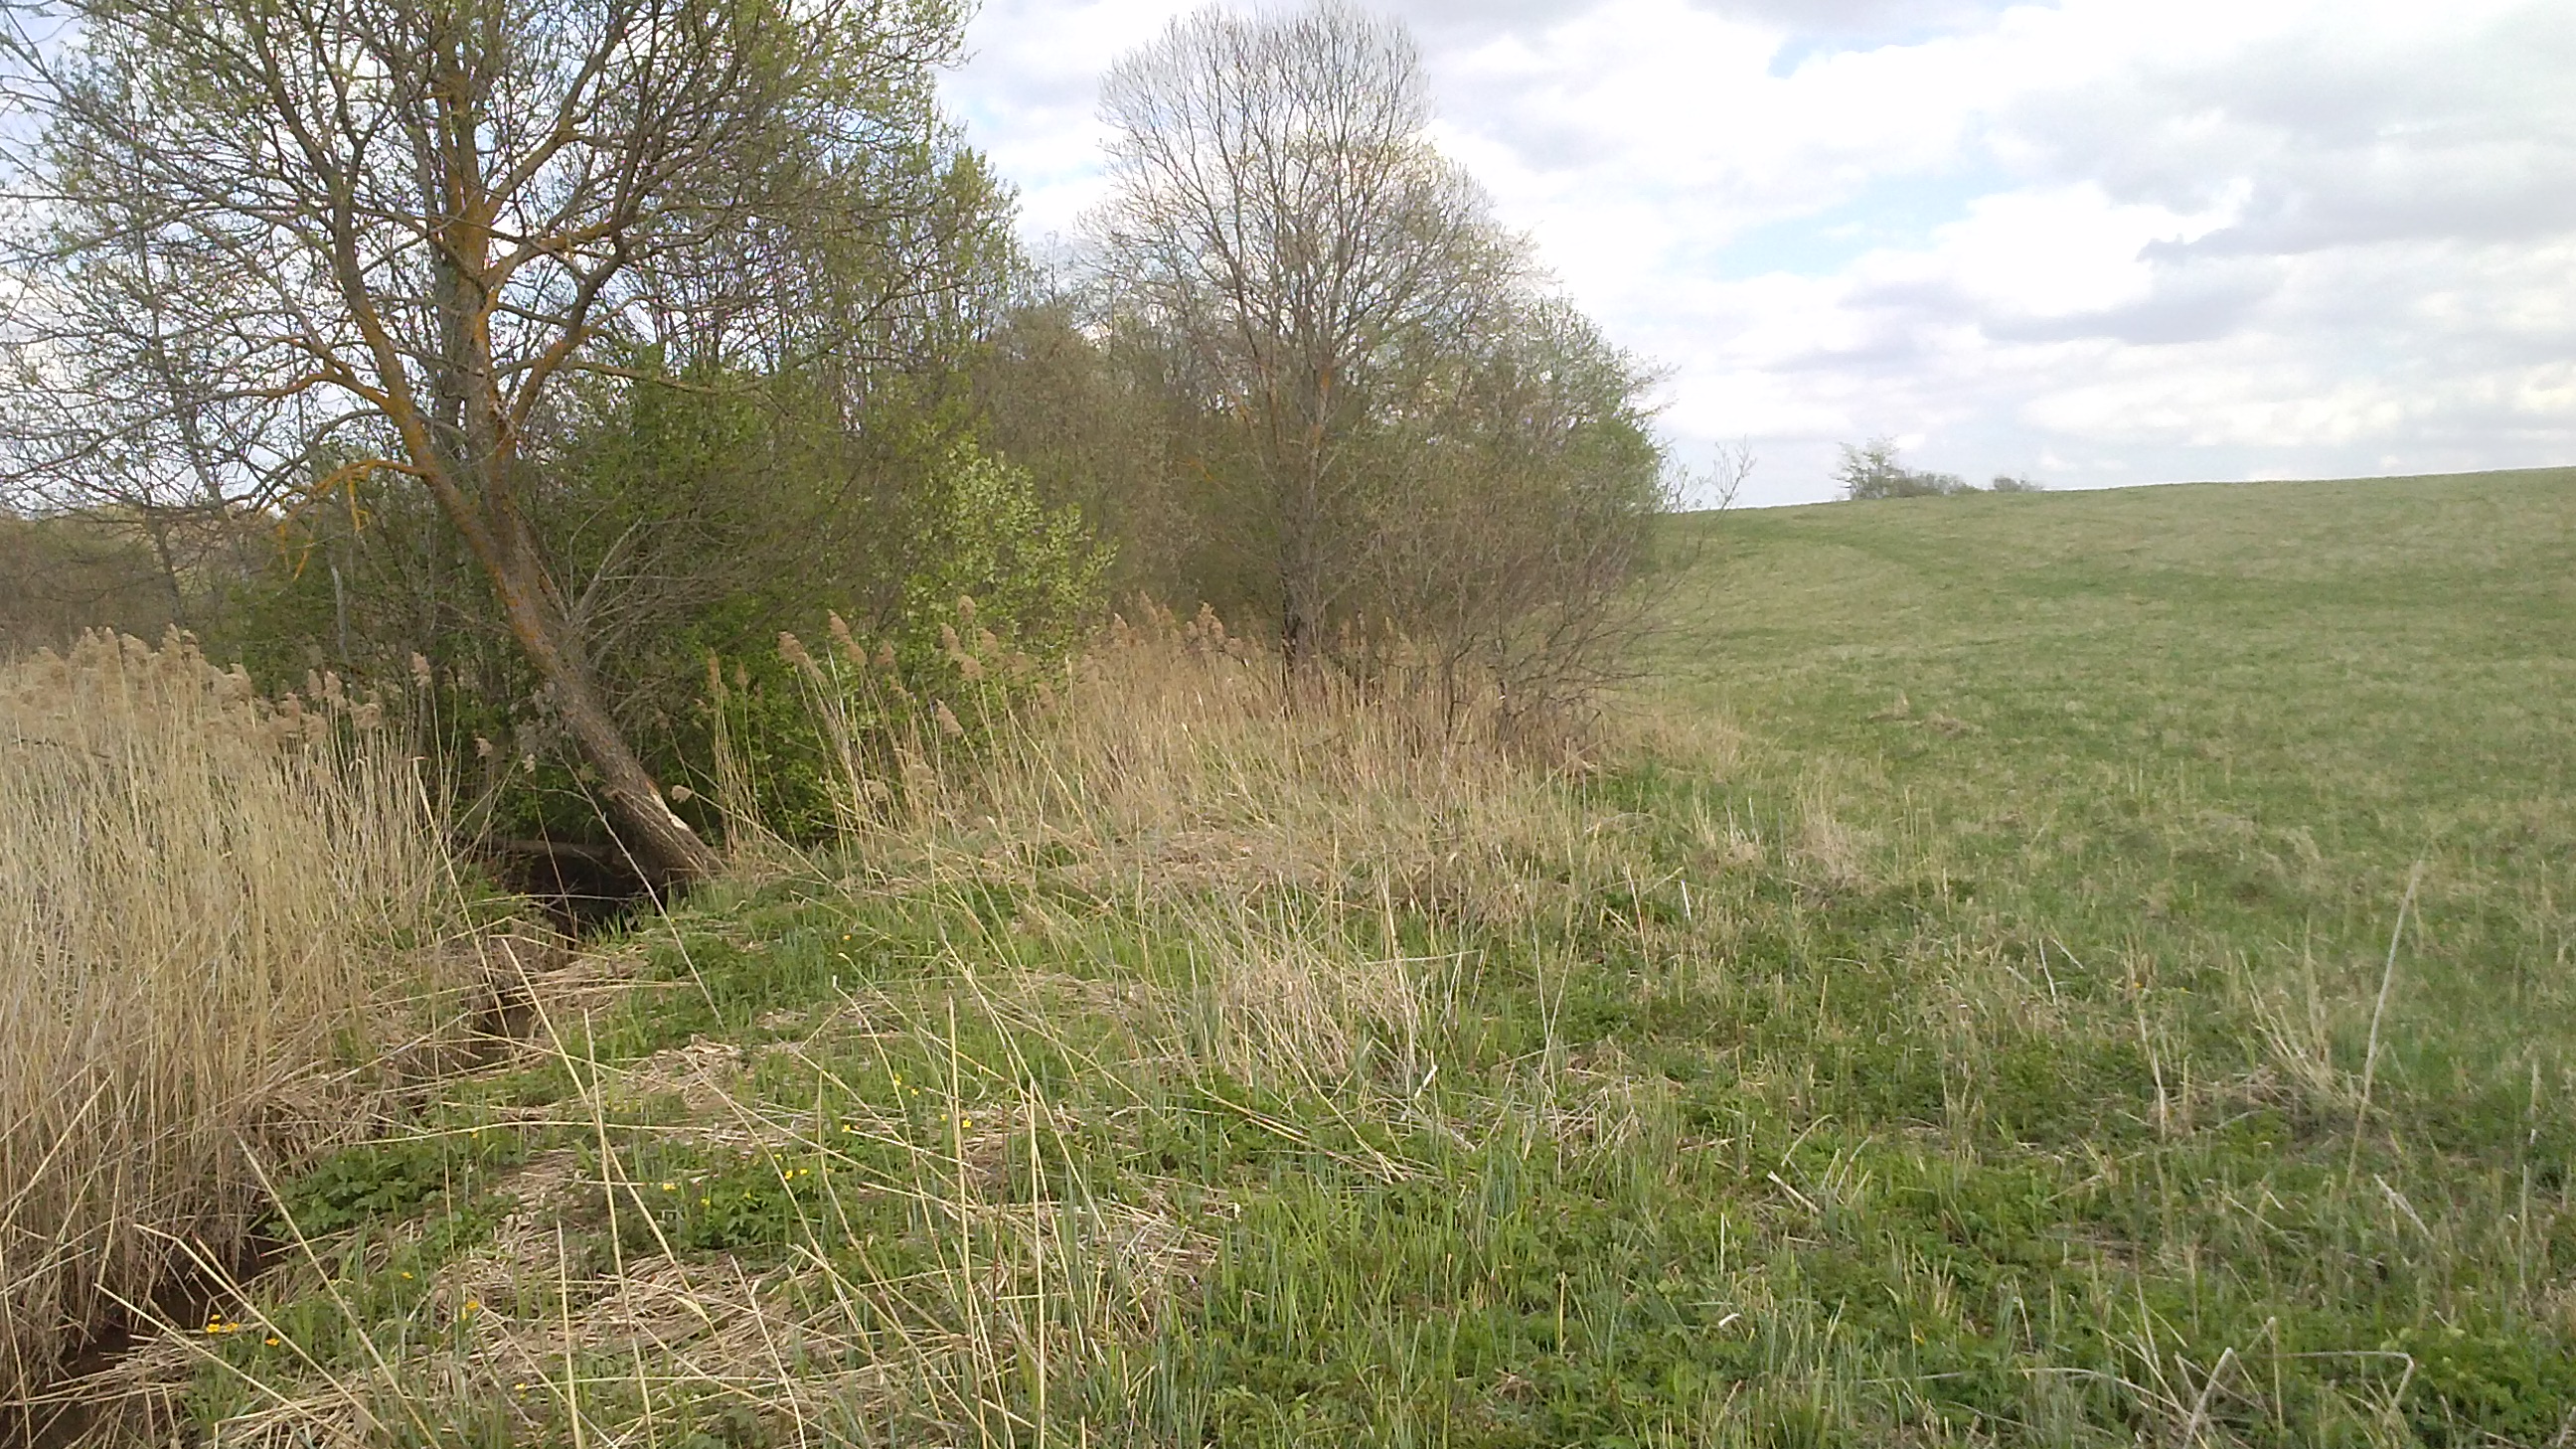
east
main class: Grassland
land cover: Grassland without tree/shrub cover
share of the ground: > 75 %
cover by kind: herbaceous plants 100 %
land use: Agriculture (excluding fallow land and kitchen gardens)
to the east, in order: Grassland without tree/shrub cover; Shruby margins; Broadleaved woodland; Ditches and canals; Shruby margins; Broadleaved woodland; Grassland with sparse tree/shrub cover; Broadleaved woodland; Ditches and canals; Broadleaved woodland; Grassland without tree/shrub cover
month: May
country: LV
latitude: 55.9452
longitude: 27.3912
